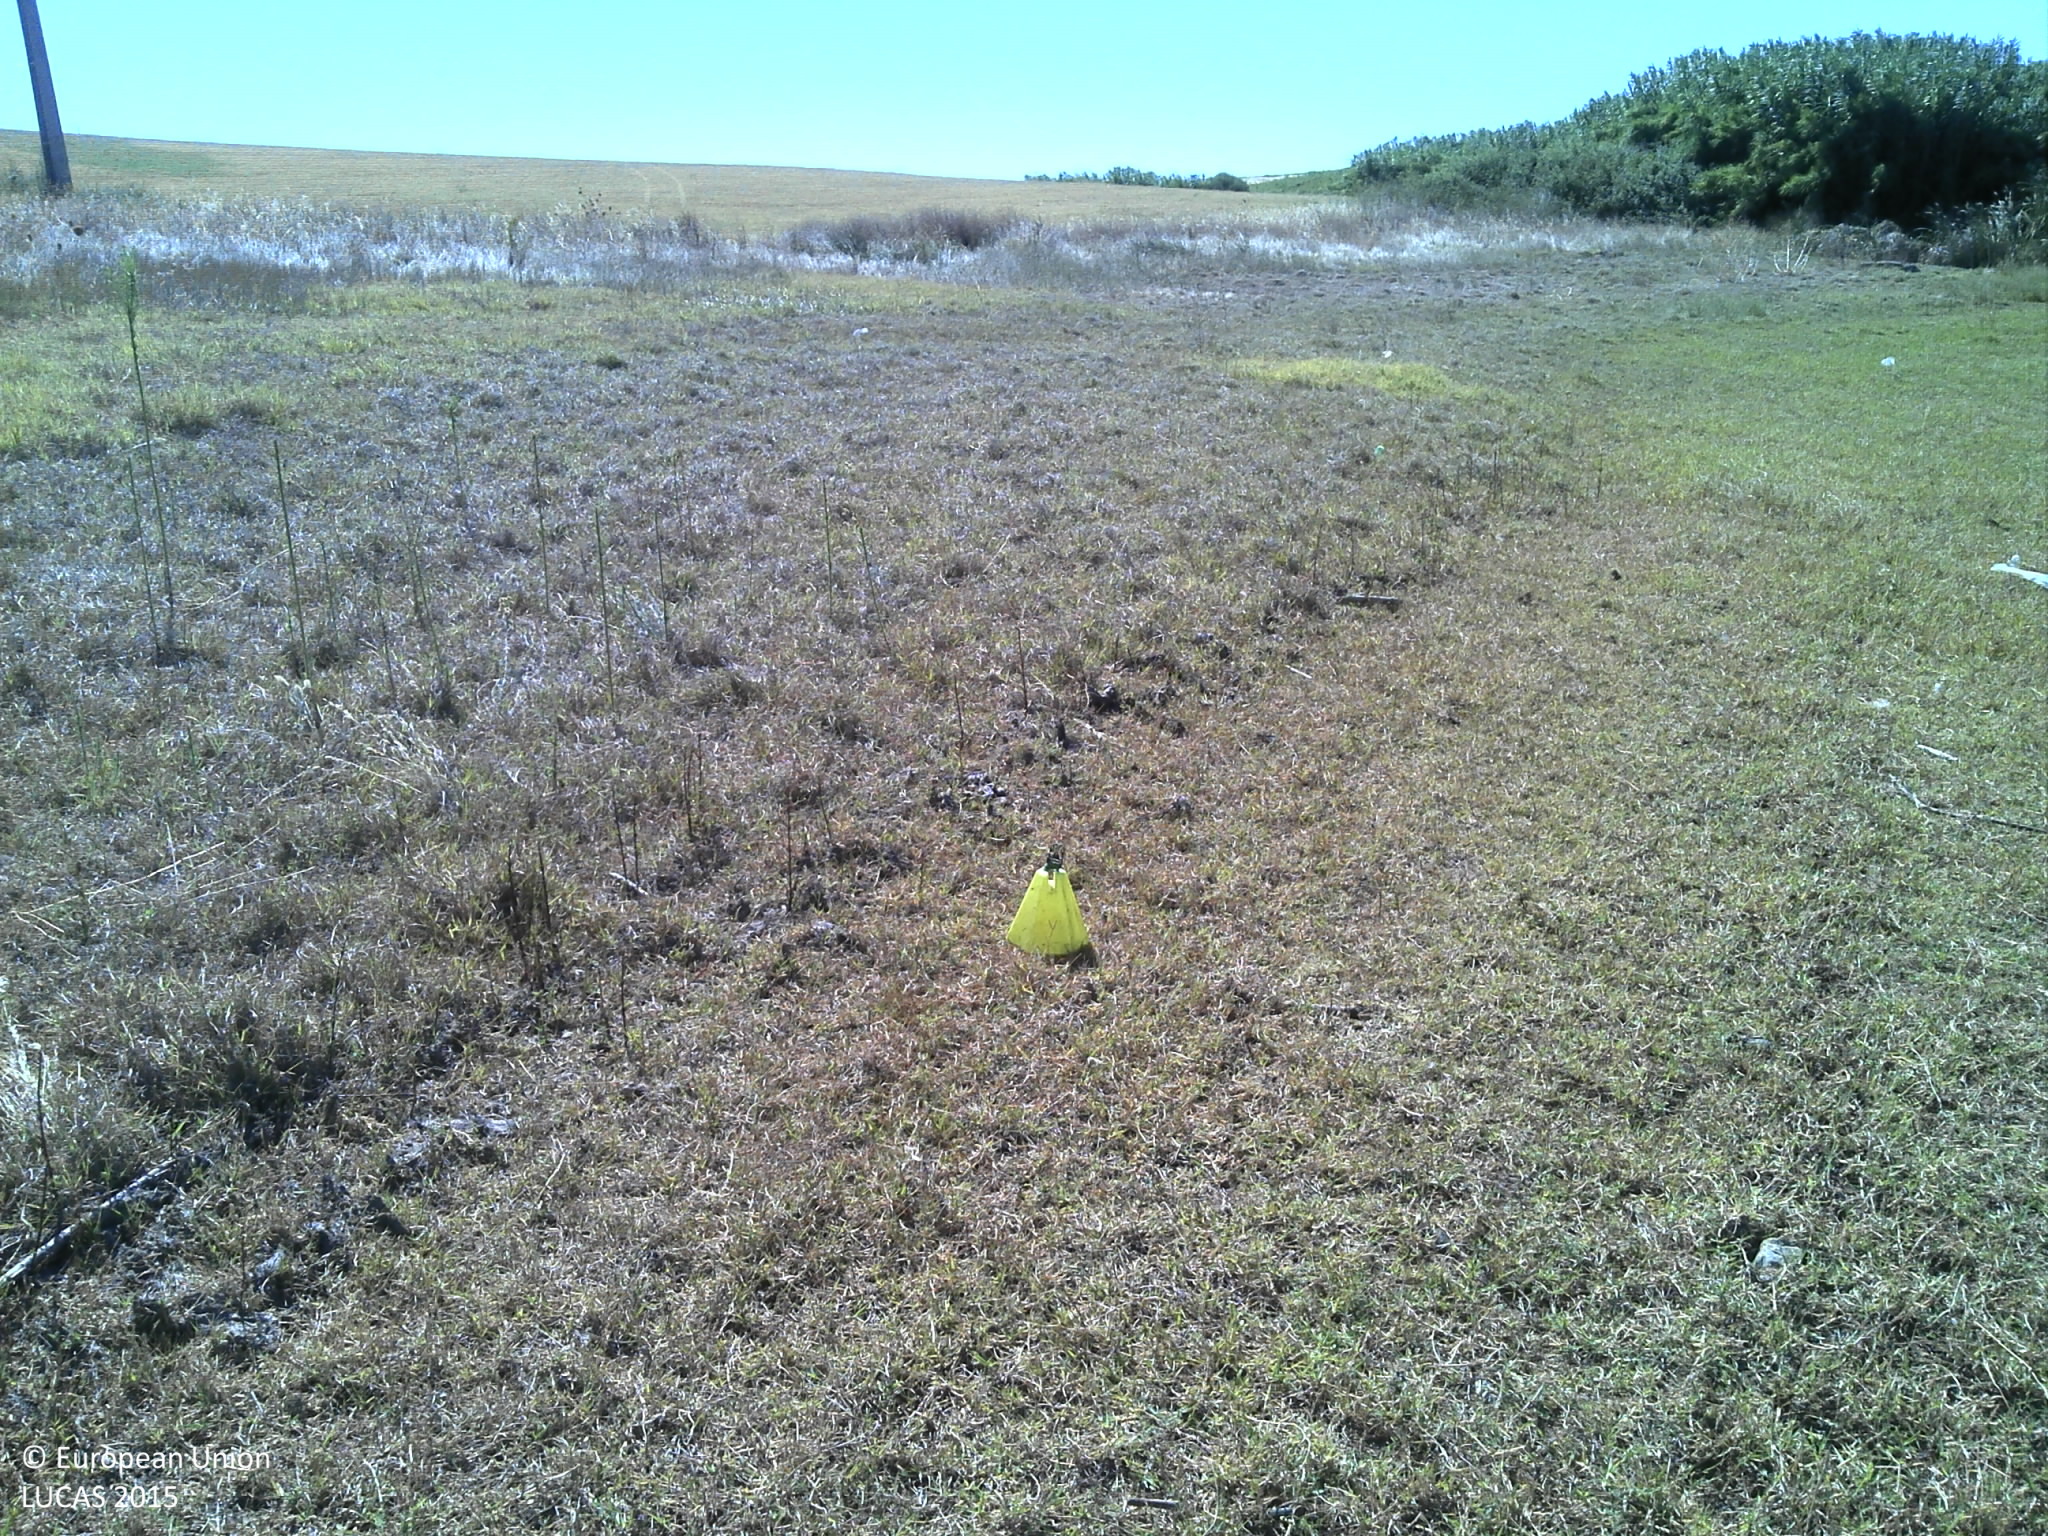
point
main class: Grassland
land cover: Grassland without tree/shrub cover
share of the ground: 10 - 25 %
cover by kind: unconsolidated bare surface 85 %, herbaceous plants 15 %
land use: Agriculture (excluding fallow land and kitchen gardens)
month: July
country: PT
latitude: 39.0237
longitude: -7.1363
